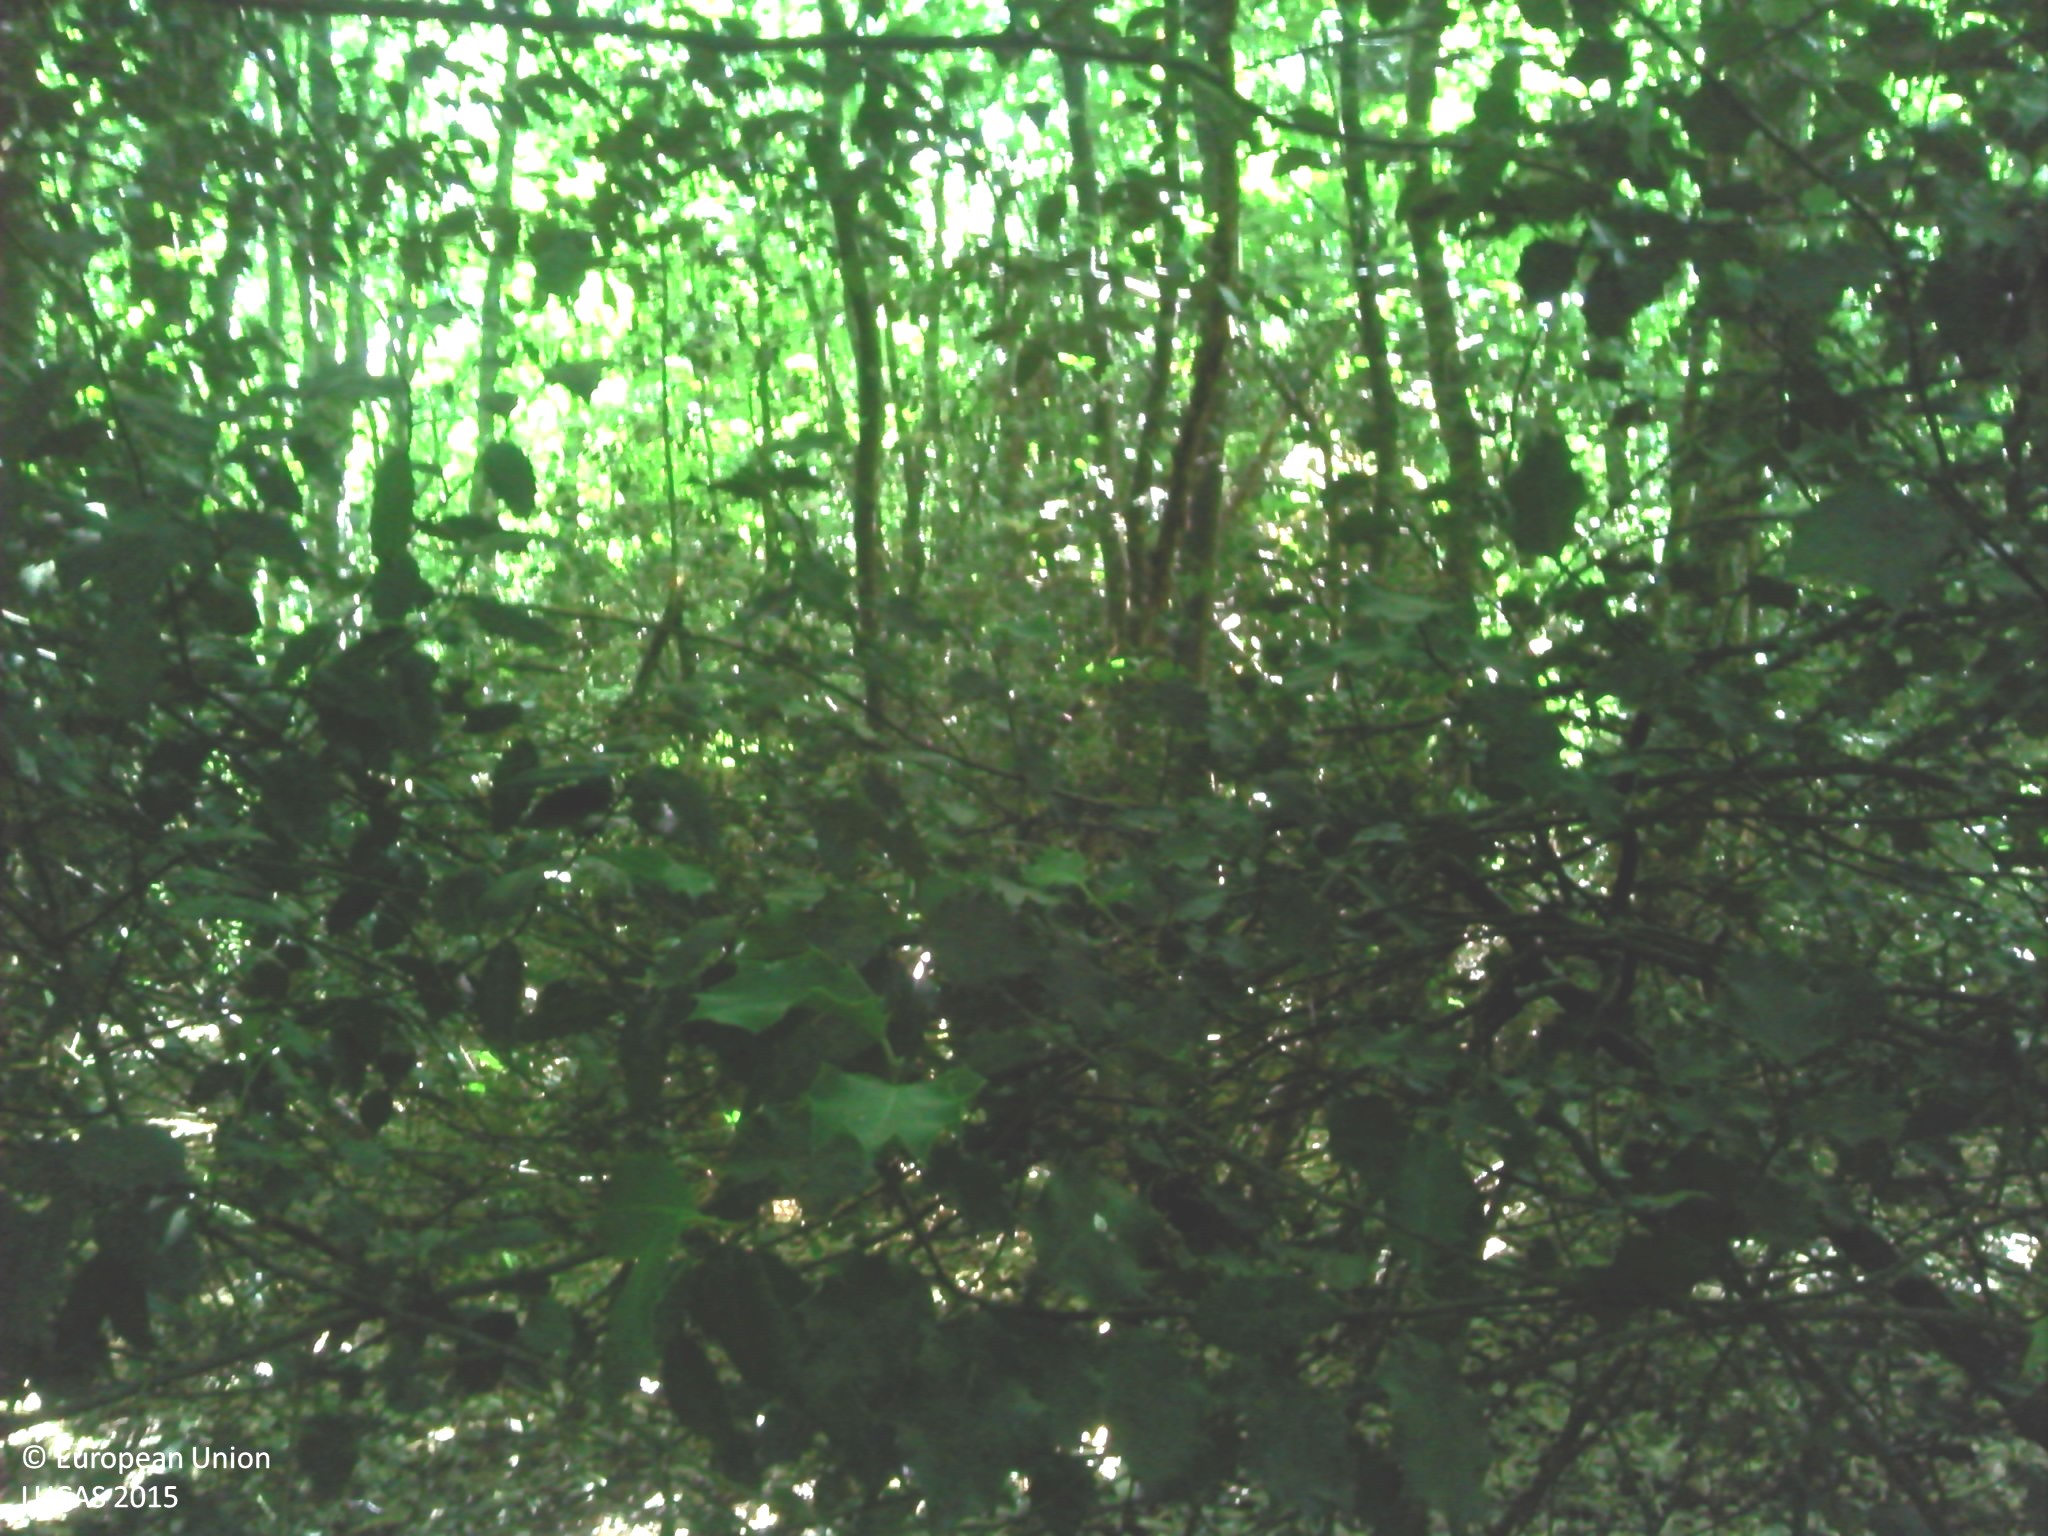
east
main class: Woodland
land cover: Broadleaved woodland
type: beech forest
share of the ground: > 75 %
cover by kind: broadleaved forest trees 75 %, consolidated bare surface 15 %, coniferous forest trees 5 %, herbaceous plants 5 %
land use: Forestry
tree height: > 5 m
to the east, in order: Broadleaved woodland; Tracks; Broadleaved woodland; Shrubland with sparse tree cover; Spruce dominated coniferous woodland
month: July
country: FR
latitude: 45.4475
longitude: 5.1588
